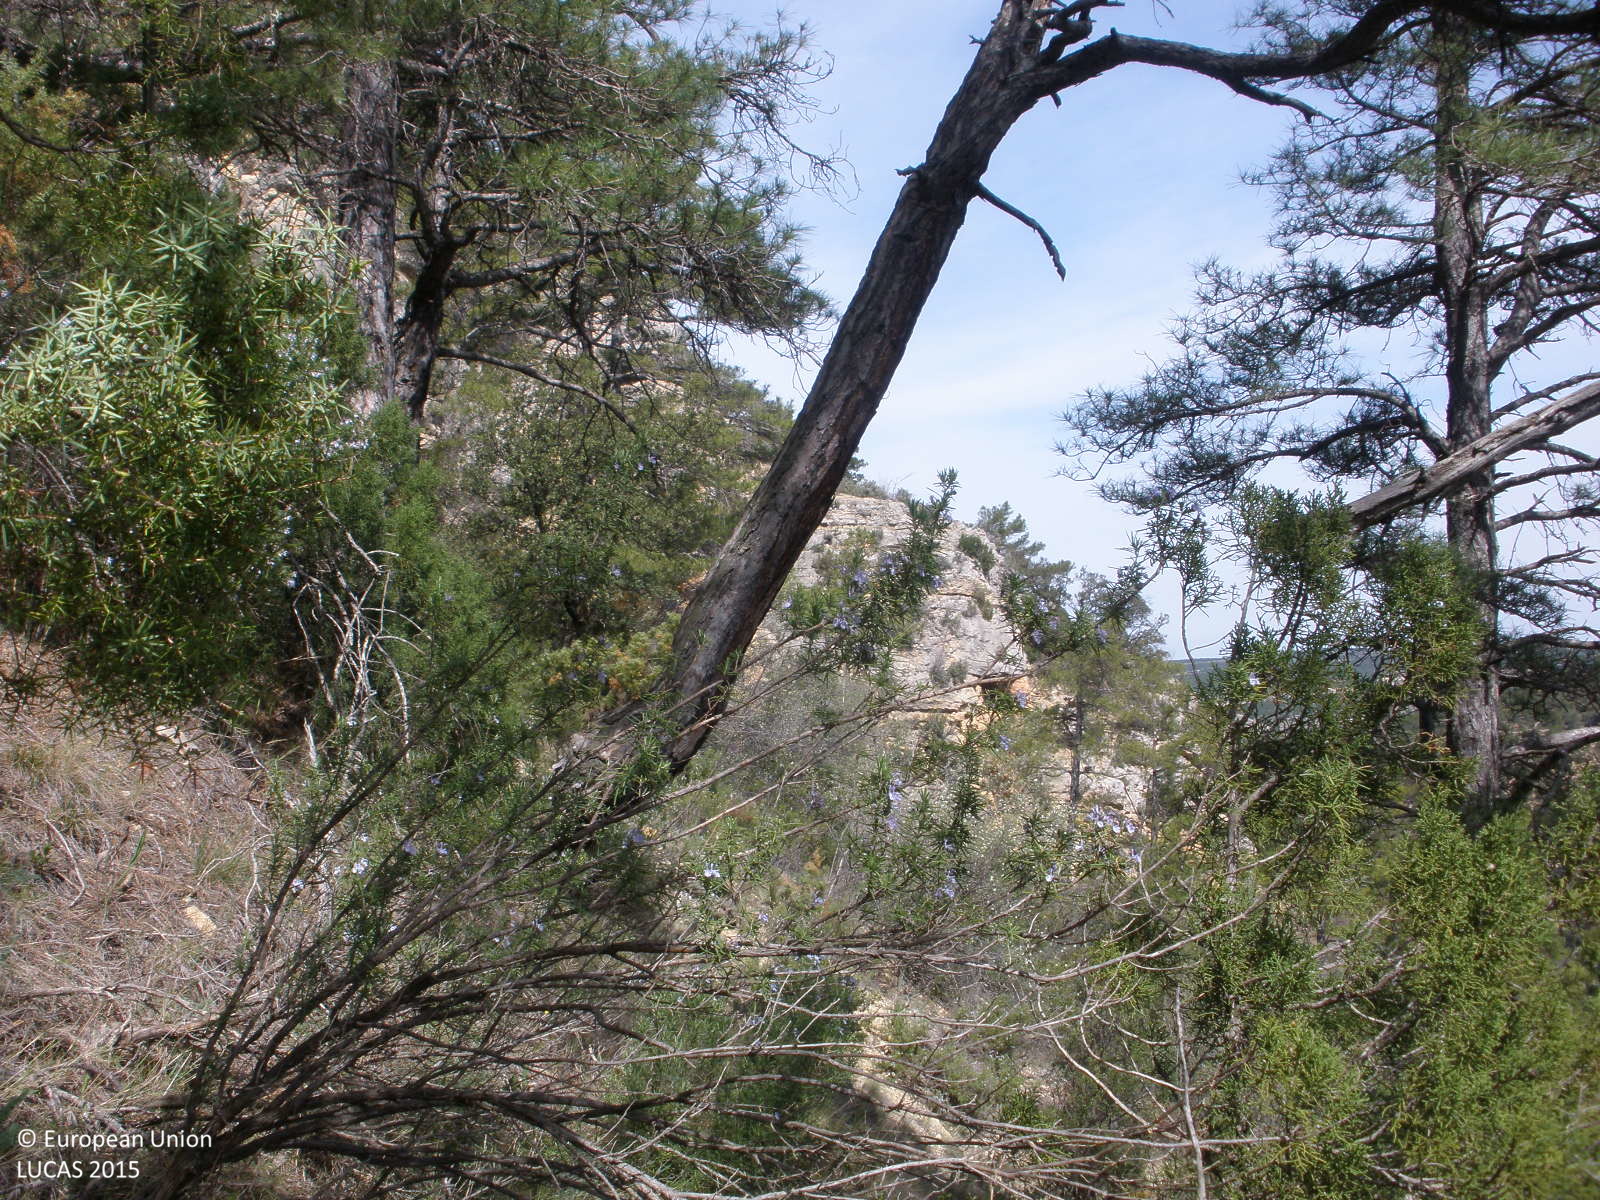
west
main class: Woodland
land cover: Pine dominated coniferous woodland
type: coniferous forest of the mediterranean region
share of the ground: > 75 %
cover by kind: coniferous forest trees 70 %, shrubs 30 %
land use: Semi-natural and natural areas not in use
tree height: > 5 m
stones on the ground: > 50 %
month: April
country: ES
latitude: 40.0461
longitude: -1.1782
